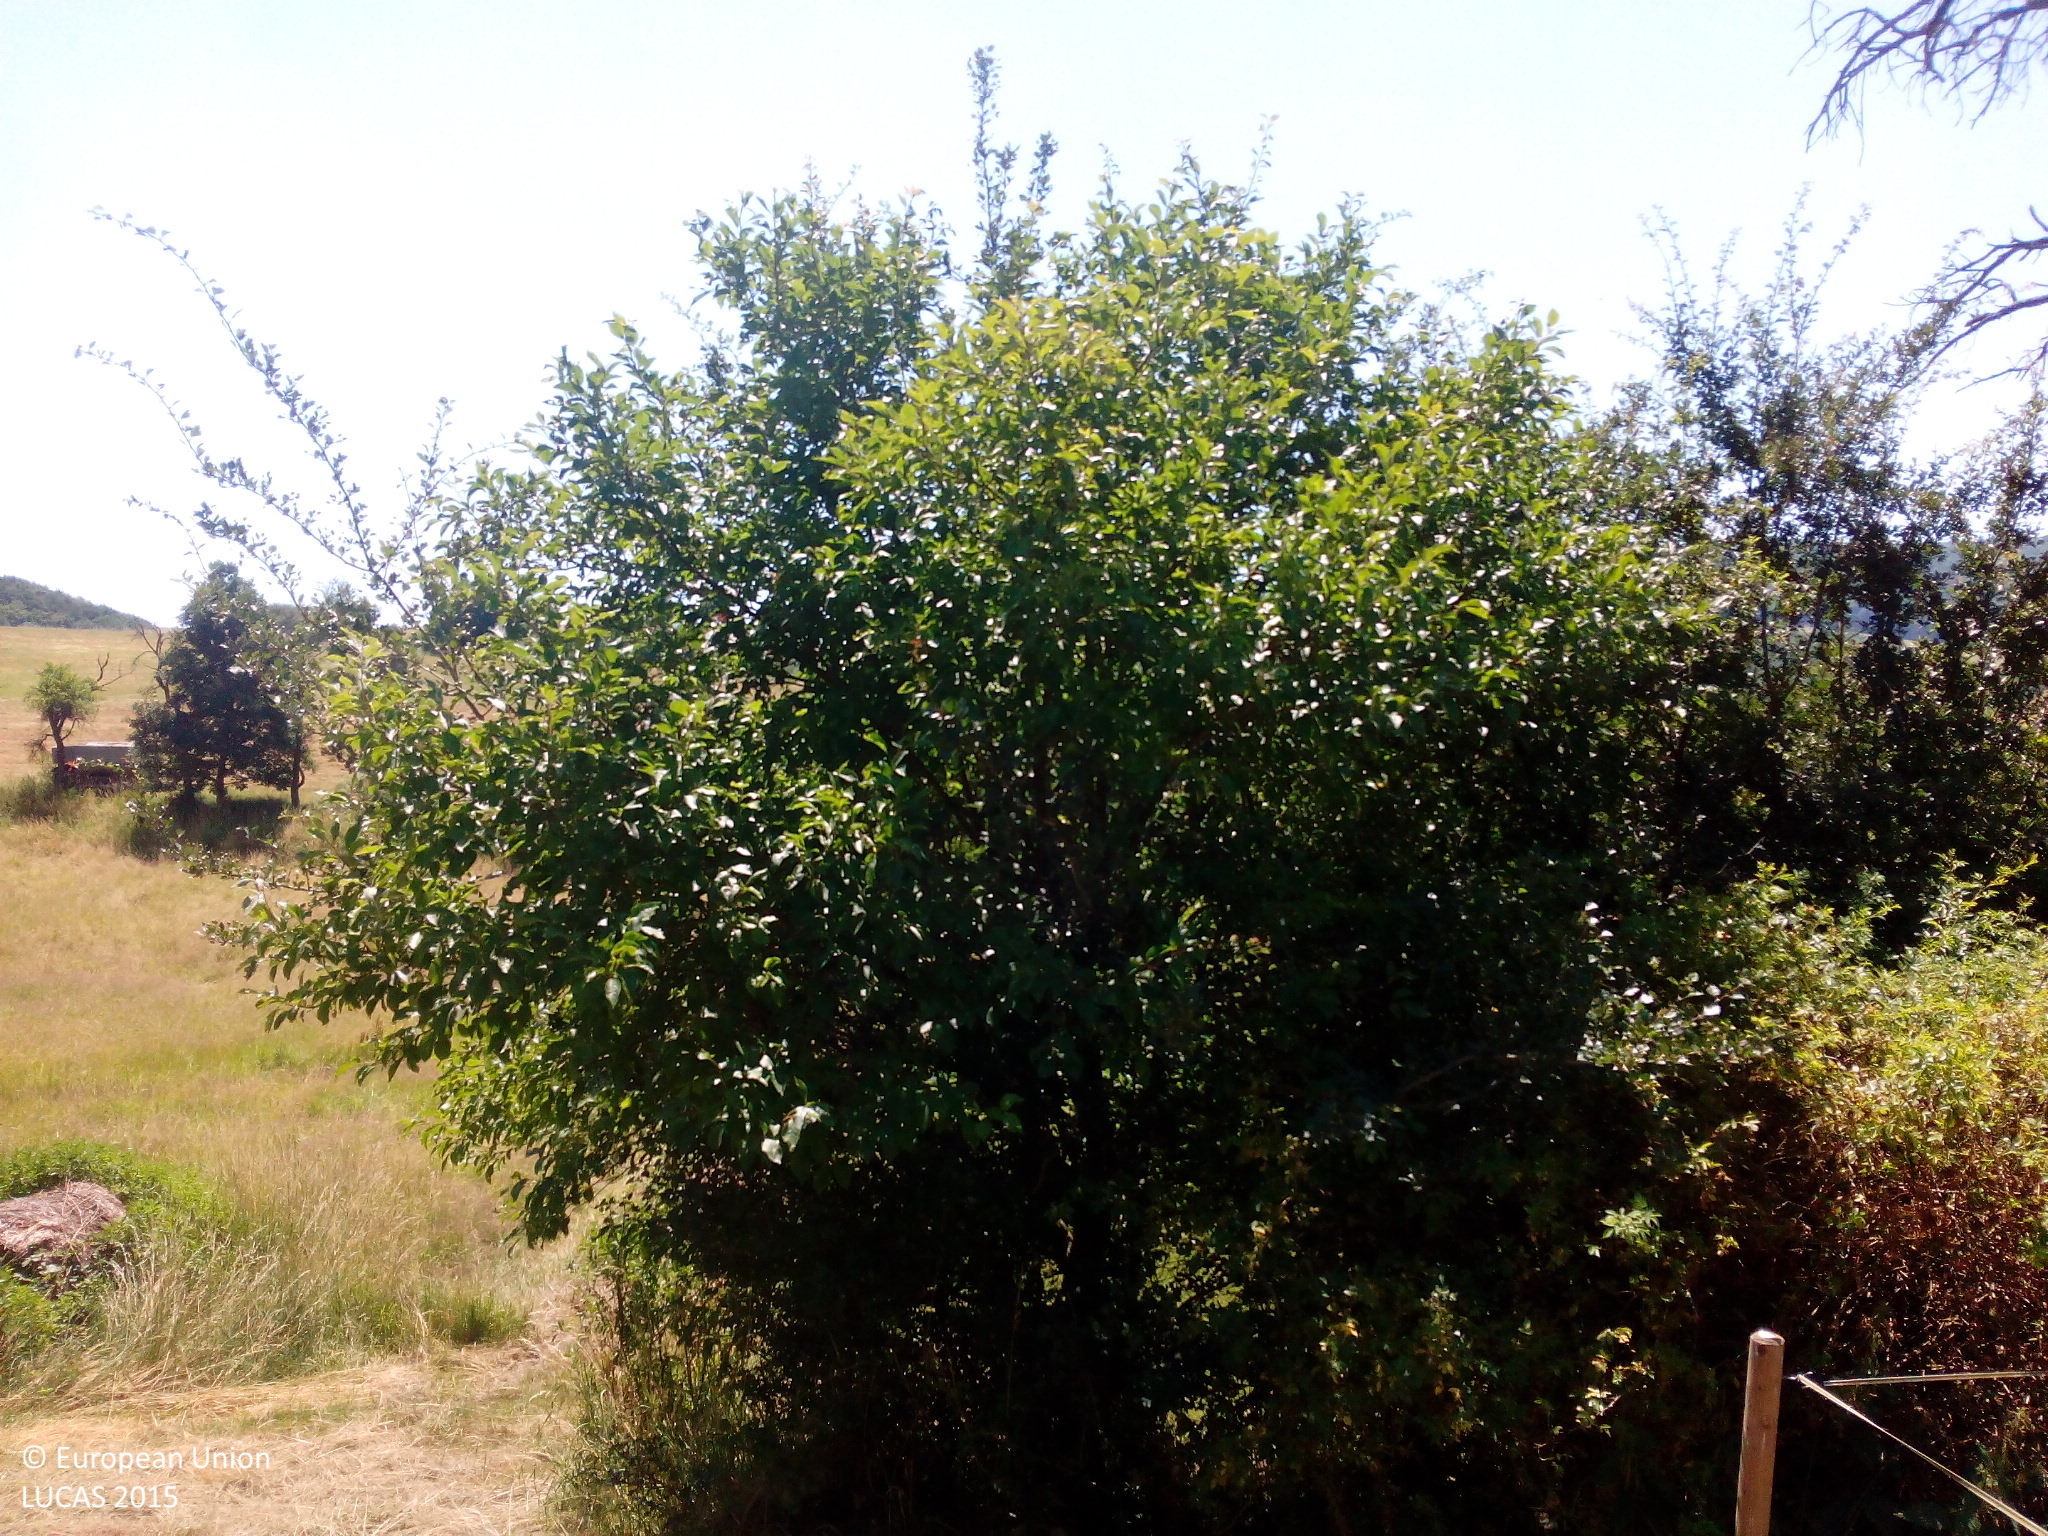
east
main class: Grassland
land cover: Grassland with sparse tree/shrub cover
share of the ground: > 75 %
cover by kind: herbaceous plants 80 %, unconsolidated bare surface 10 %, broadleaved forest trees 5 %, shrubs 5 %
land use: Agriculture (excluding fallow land and kitchen gardens)
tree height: < 5 m
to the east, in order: Grassland with sparse tree/shrub cover; Fences; Shrubland with sparse tree cover; Grassland without tree/shrub cover; Single bushes/trees; Spontaneously vegetated surfaces; Grassland with sparse tree/shrub cover
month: July
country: DE
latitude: 49.5823
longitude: 7.5523
